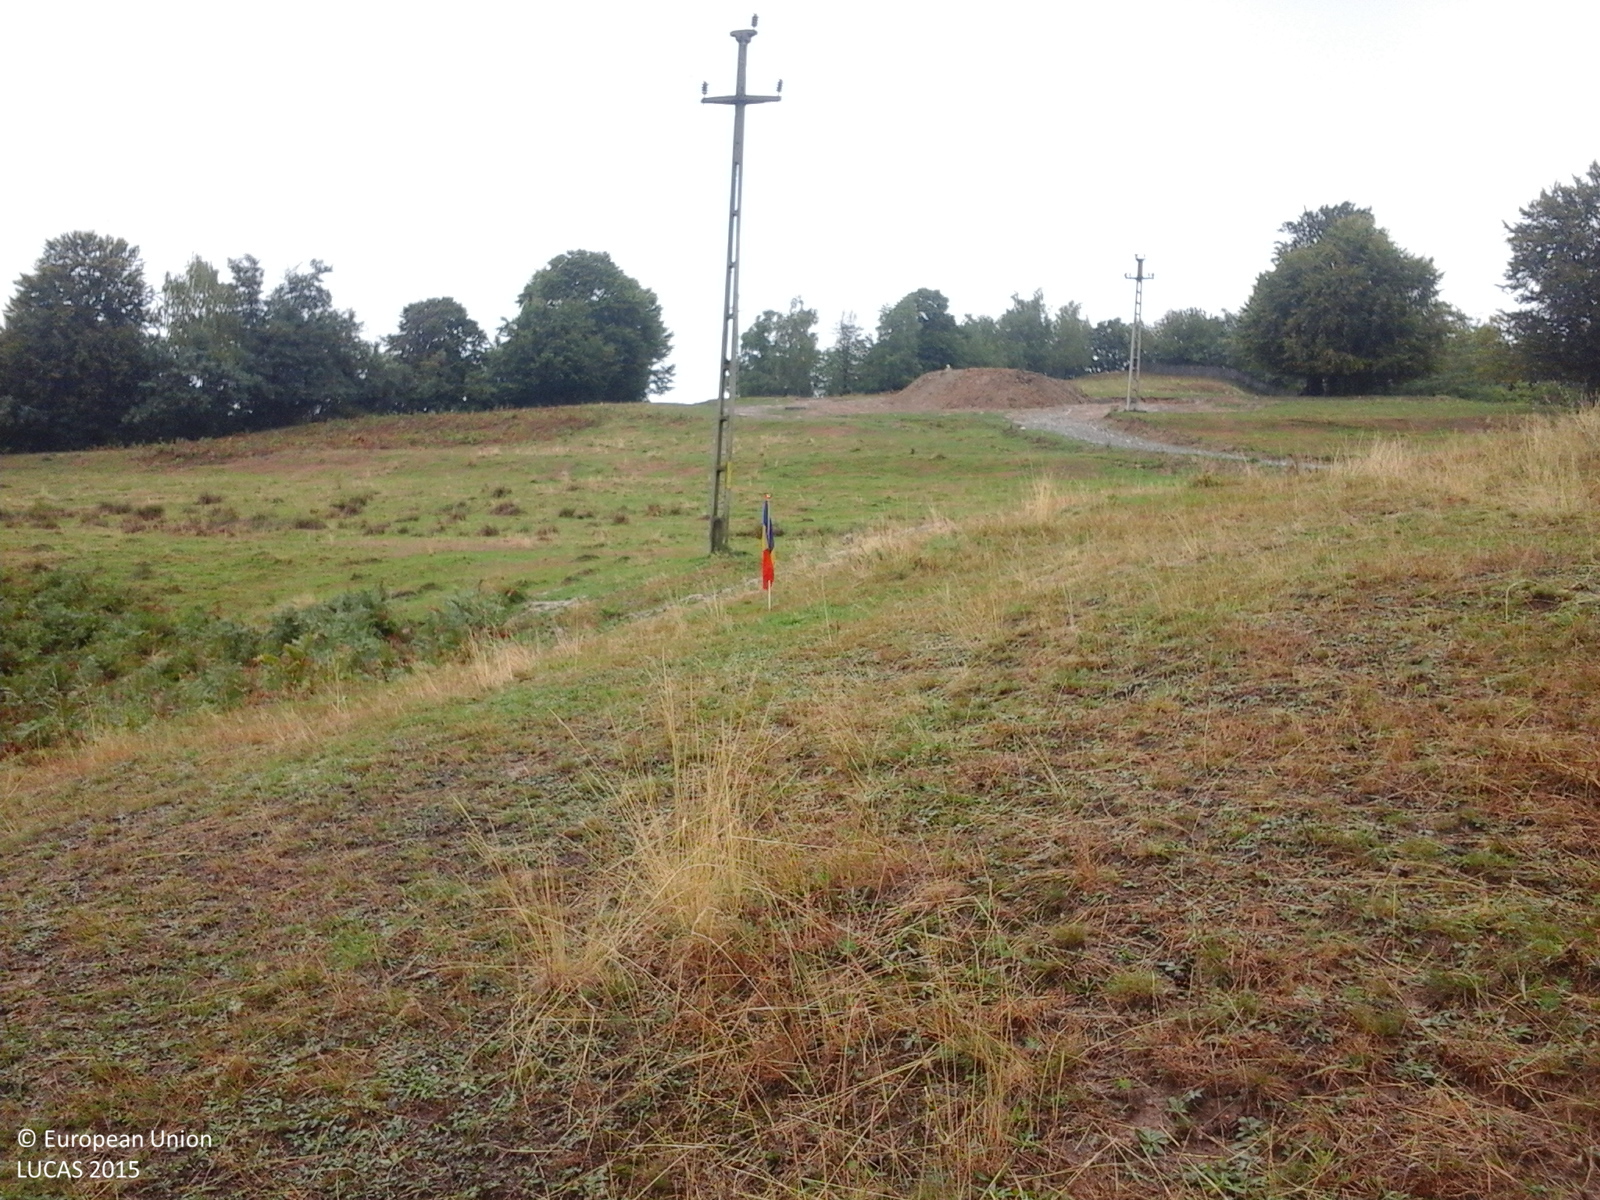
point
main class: Grassland
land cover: Grassland without tree/shrub cover
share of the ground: > 75 %
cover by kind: herbaceous plants 100 %
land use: Agriculture (excluding fallow land and kitchen gardens)
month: September
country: RO
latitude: 45.2452
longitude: 24.5125
